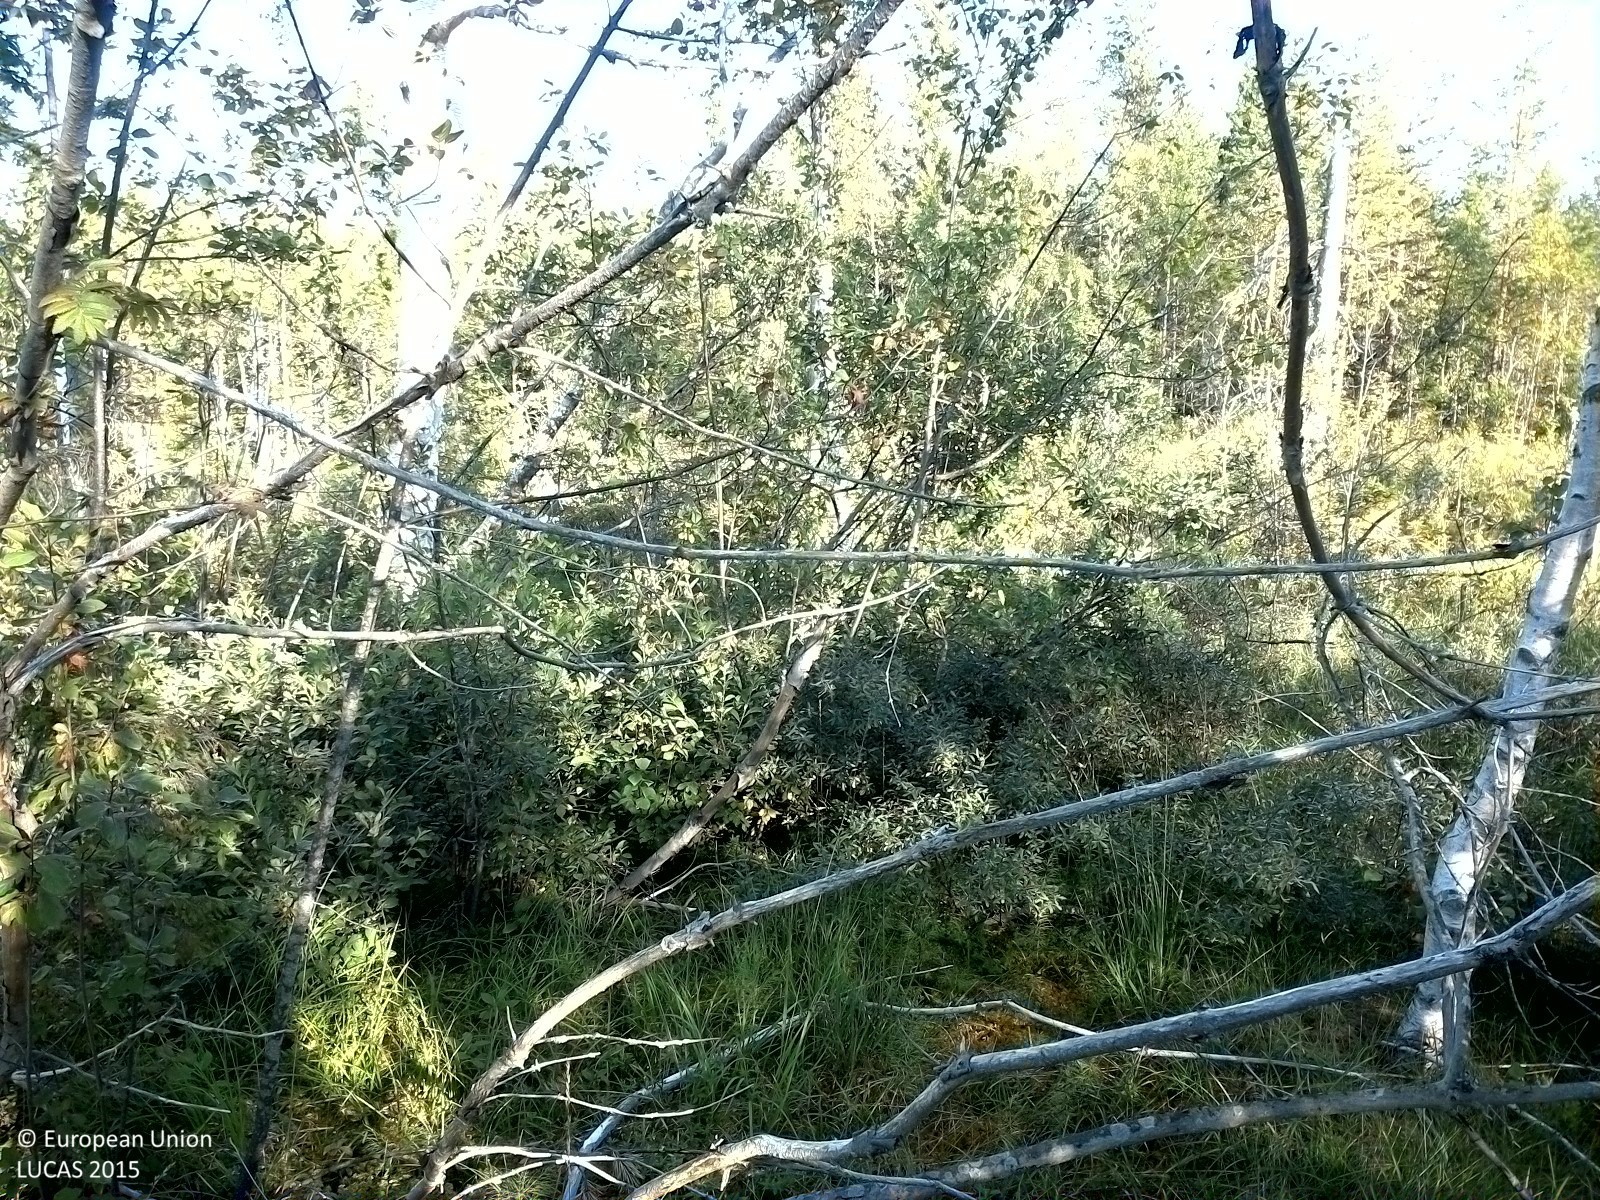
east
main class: Woodland
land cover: Other mixed woodland
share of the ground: 50 - 75 %
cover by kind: coniferous forest trees 30 %, broadleaved forest trees 20 %, herbaceous plants 20 %, lichens and mosses 20 %, shrubs 10 %
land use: Forestry
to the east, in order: Other mixed woodland; Rivers and streams; Other mixed woodland; Rivers and streams; Other mixed woodland; Rivers and streams; Spruce dominated coniferous woodland; Tracks; Spruce dominated coniferous woodland; Tracks; Spruce dominated mixed woodland
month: August
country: SE
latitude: 62.6058
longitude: 17.8704
